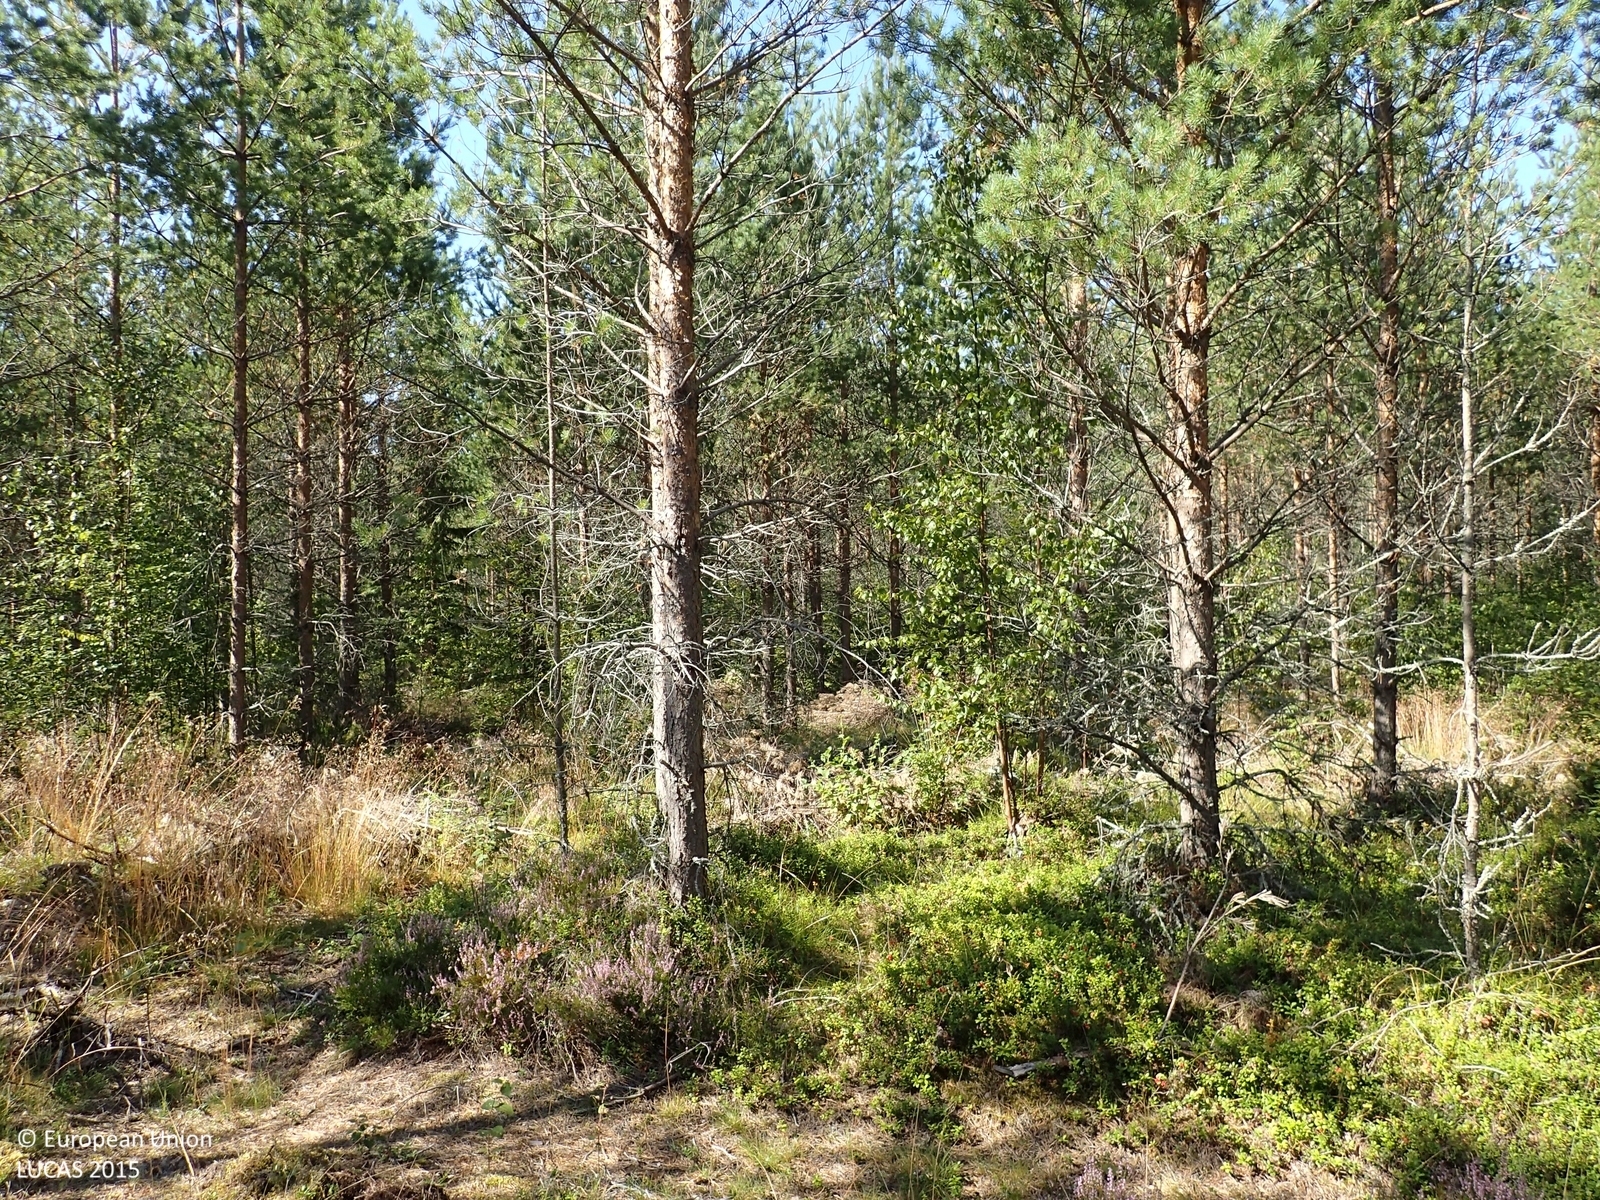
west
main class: Woodland
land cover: Pine dominated coniferous woodland
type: boreal forest
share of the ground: > 75 %
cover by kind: coniferous forest trees 75 %, shrubs 15 %, broadleaved forest trees 5 %, herbaceous plants 5 %
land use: Forestry
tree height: < 5 m
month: August
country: FI
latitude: 62.5331
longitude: 21.7648
